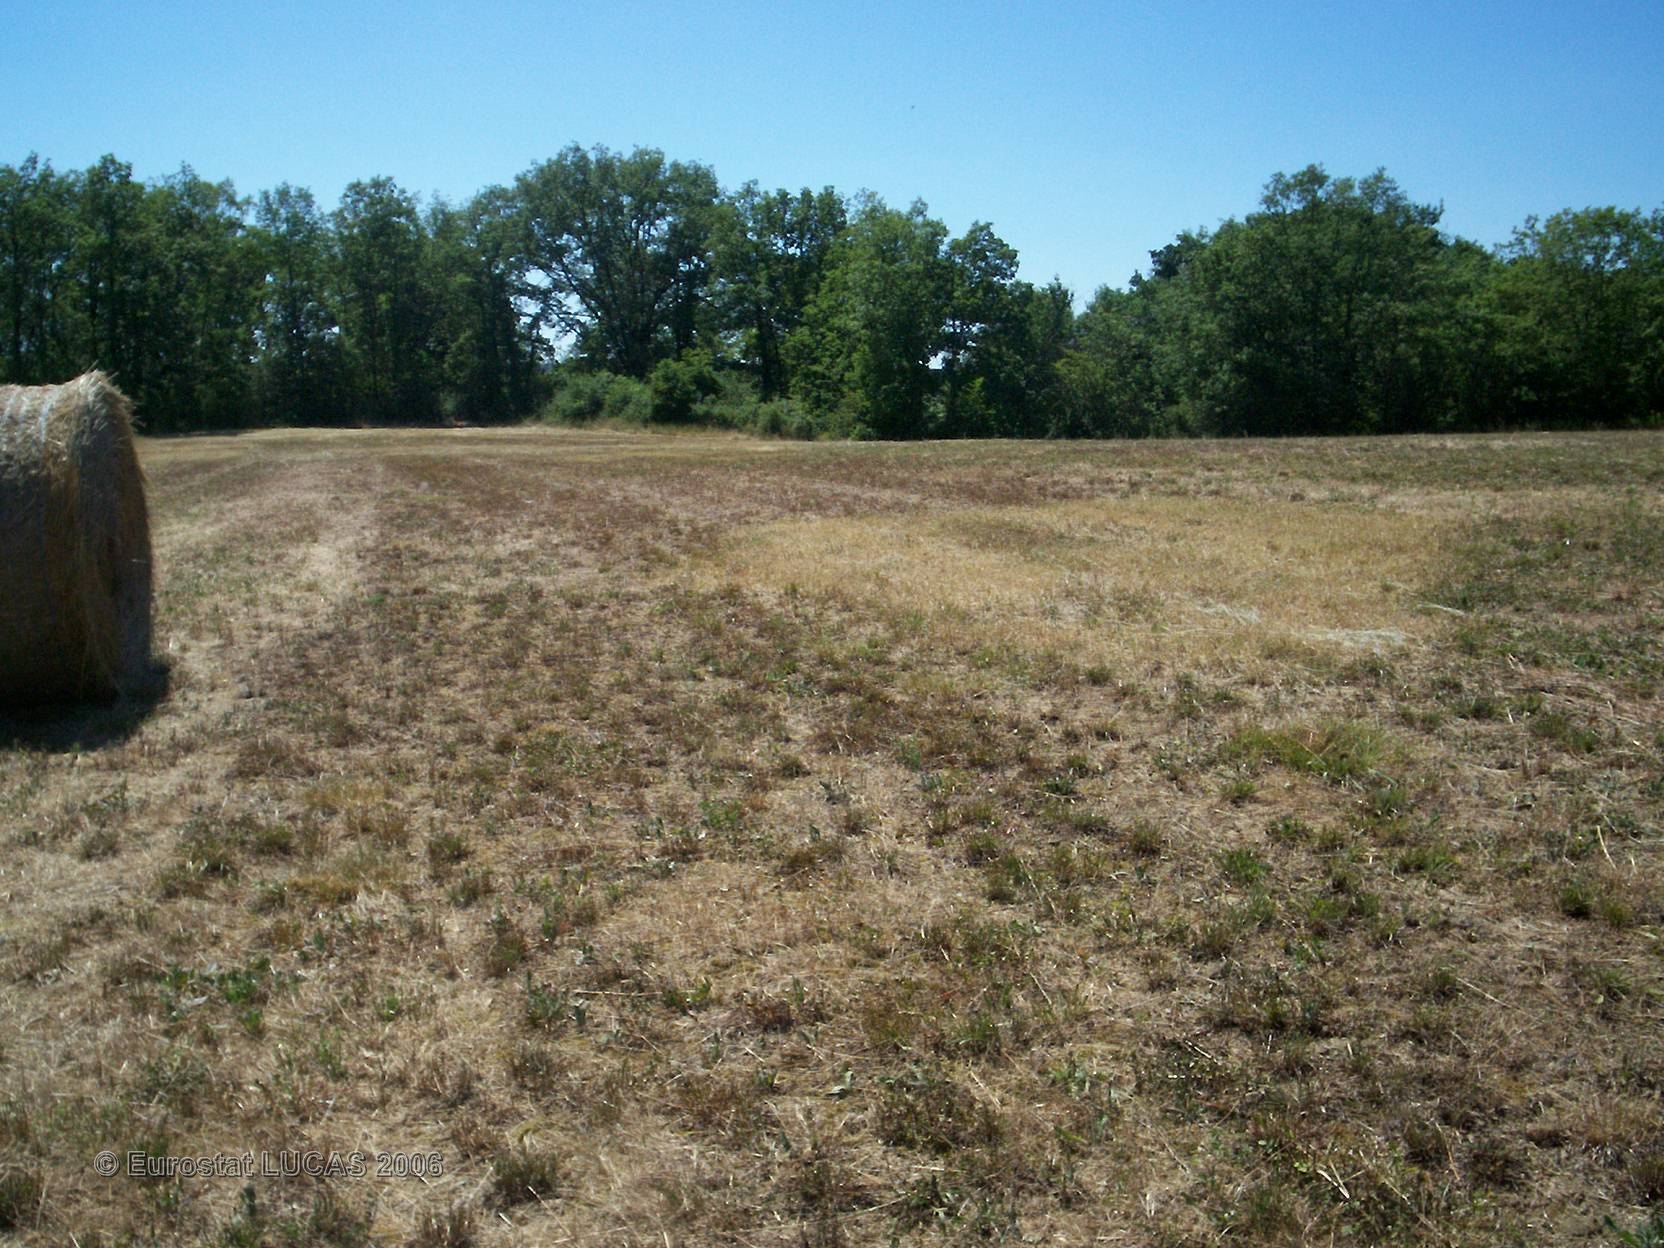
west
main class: Grassland
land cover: Grassland without tree/shrub cover
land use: Agriculture (excluding fallow land and kitchen gardens)
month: June
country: FR
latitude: 43.8351
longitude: 0.8324
